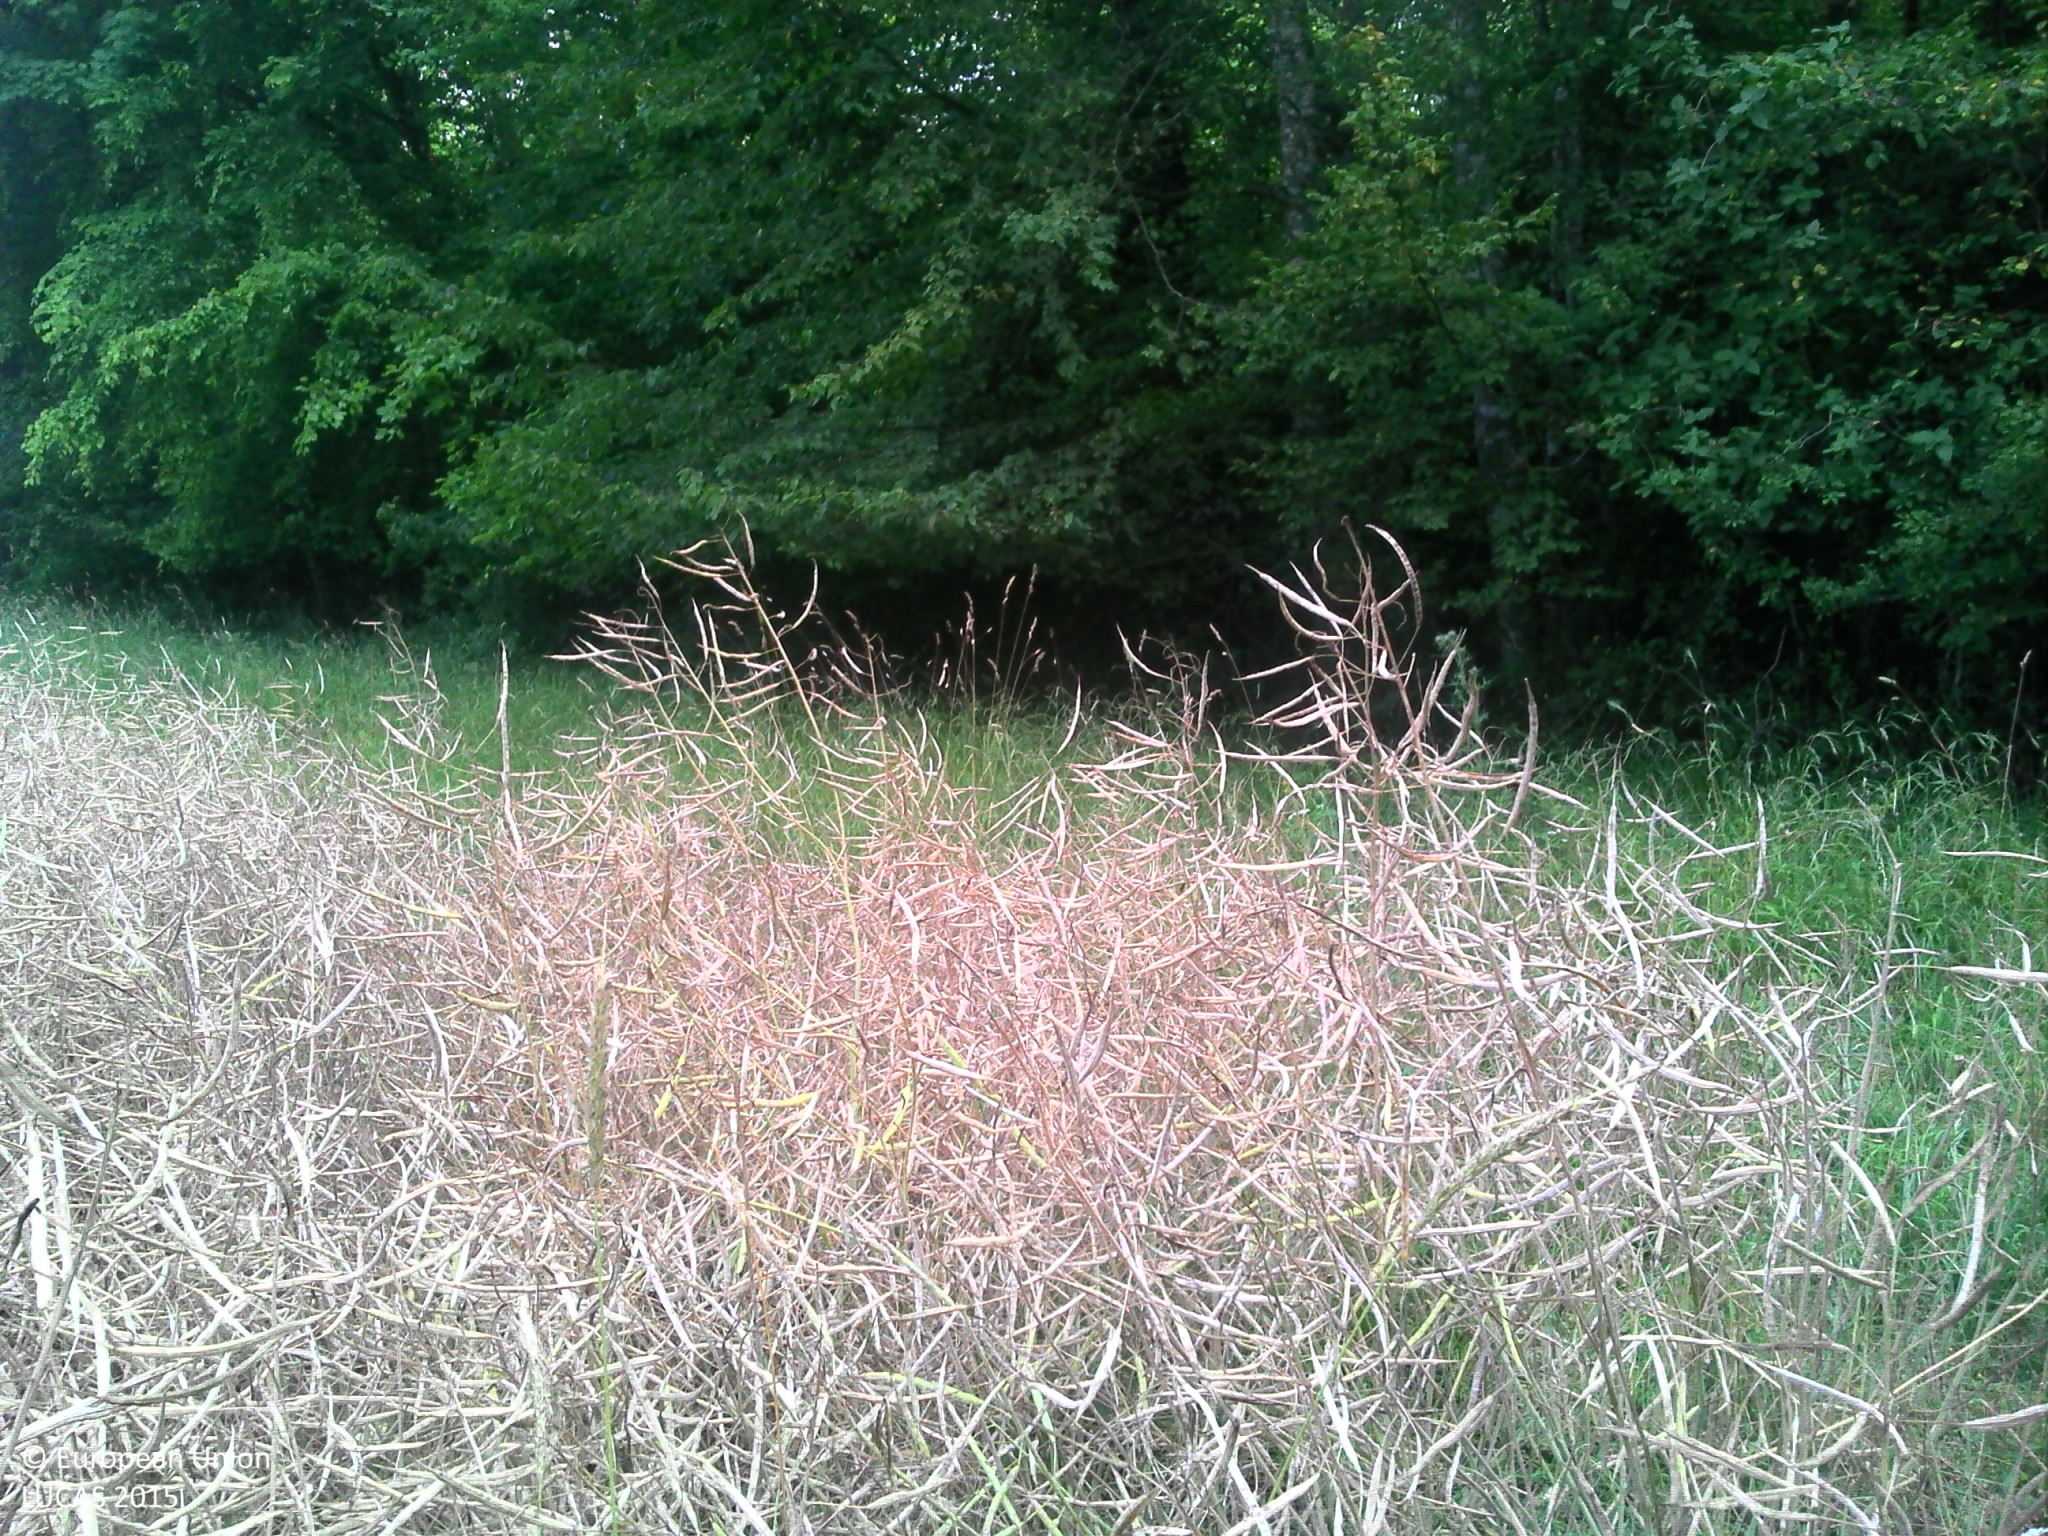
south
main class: Cropland
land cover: Rape and turnip rape
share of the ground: > 75 %
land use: Agriculture (excluding fallow land and kitchen gardens)
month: July
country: FR
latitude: 48.0833
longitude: 5.2070
